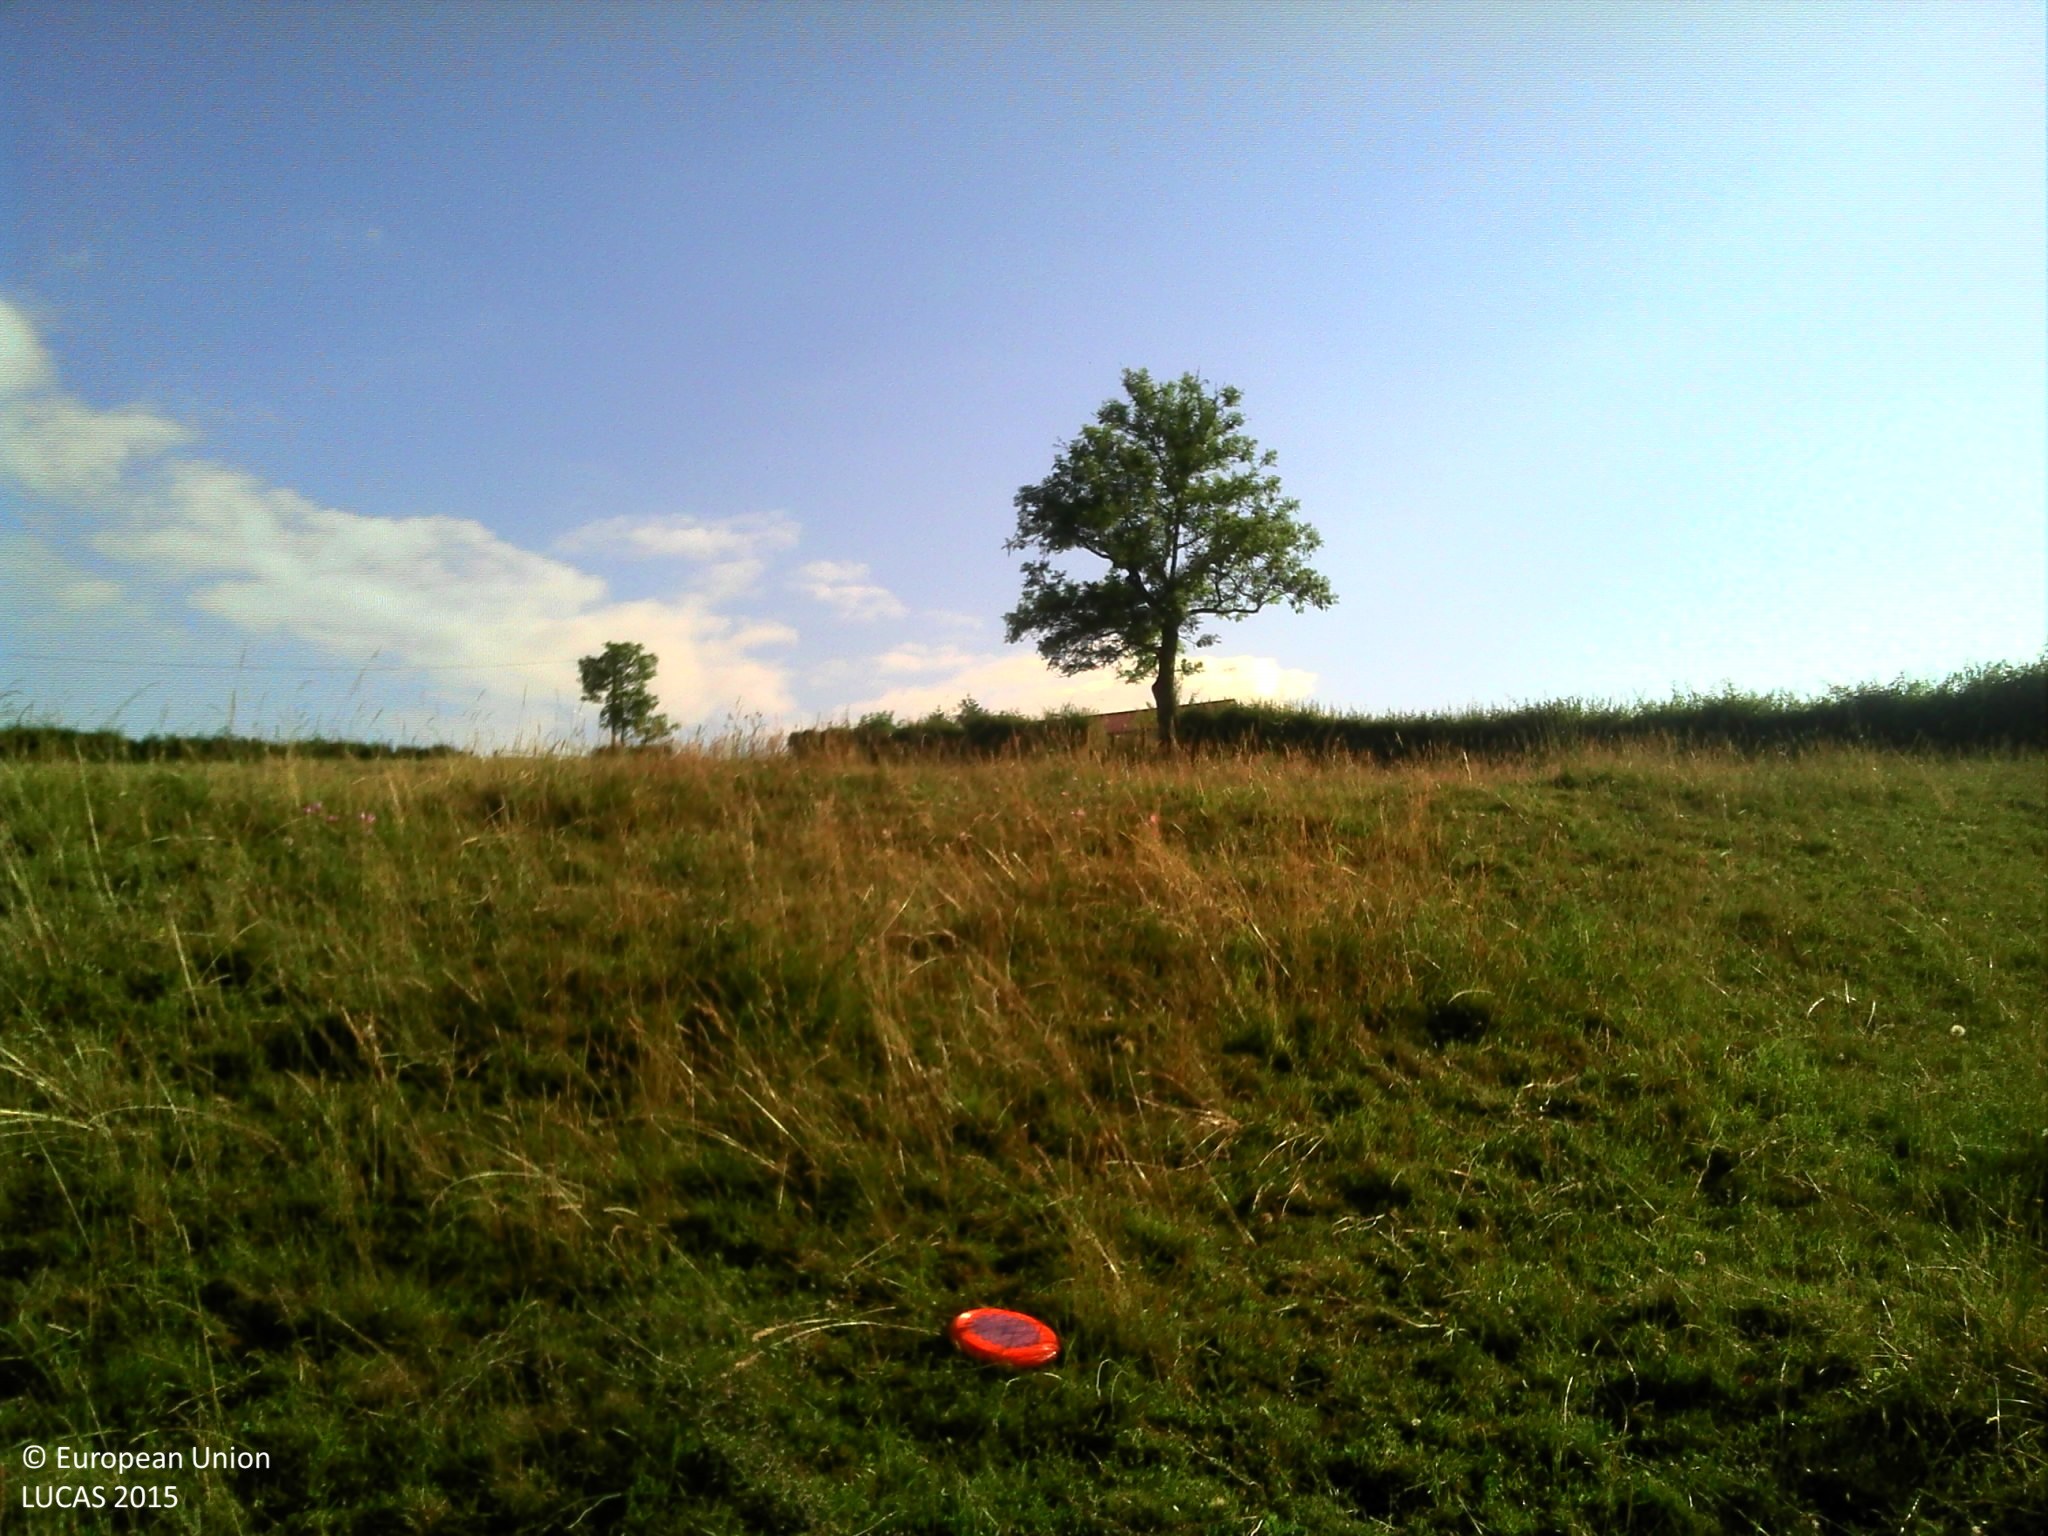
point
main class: Grassland
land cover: Grassland without tree/shrub cover
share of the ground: > 75 %
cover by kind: herbaceous plants 100 %
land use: Agriculture (excluding fallow land and kitchen gardens)
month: June
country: FR
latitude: 46.4967
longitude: 4.4637
